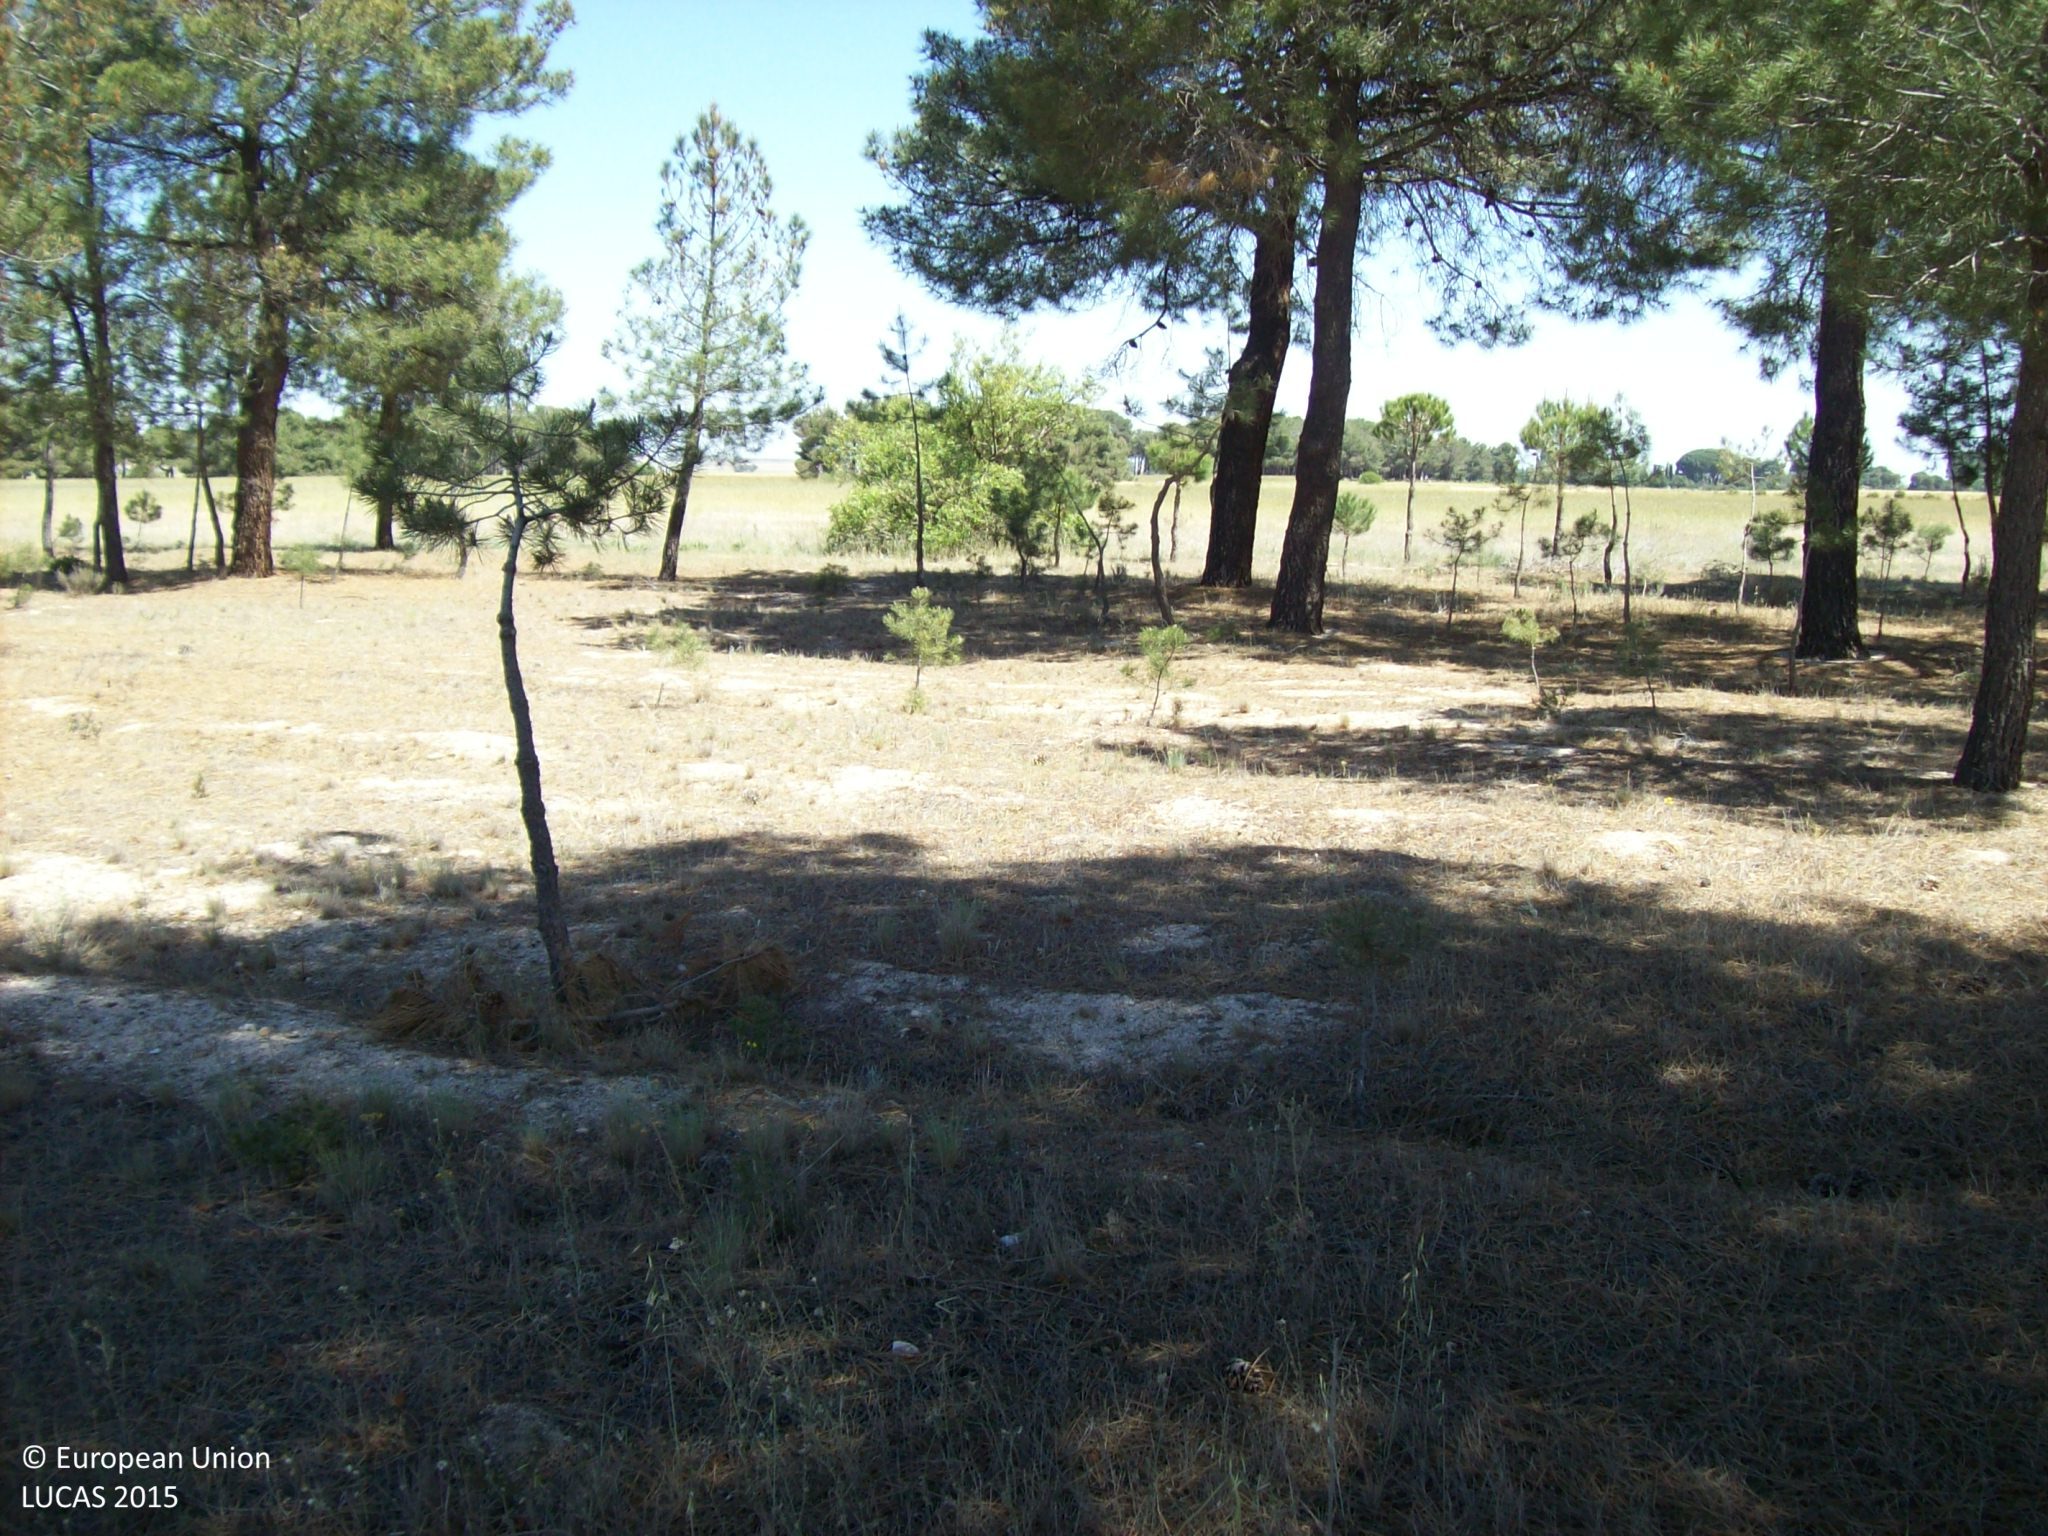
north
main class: Woodland
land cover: Pine dominated coniferous woodland
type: coniferous forest of the mediterranean region
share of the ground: 25 - 50 %
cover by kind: unconsolidated bare surface 50 %, coniferous forest trees 30 %, herbaceous plants 10 %
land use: Forestry
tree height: < 5 m
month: May
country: ES
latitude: 40.8125
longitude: -4.8915
